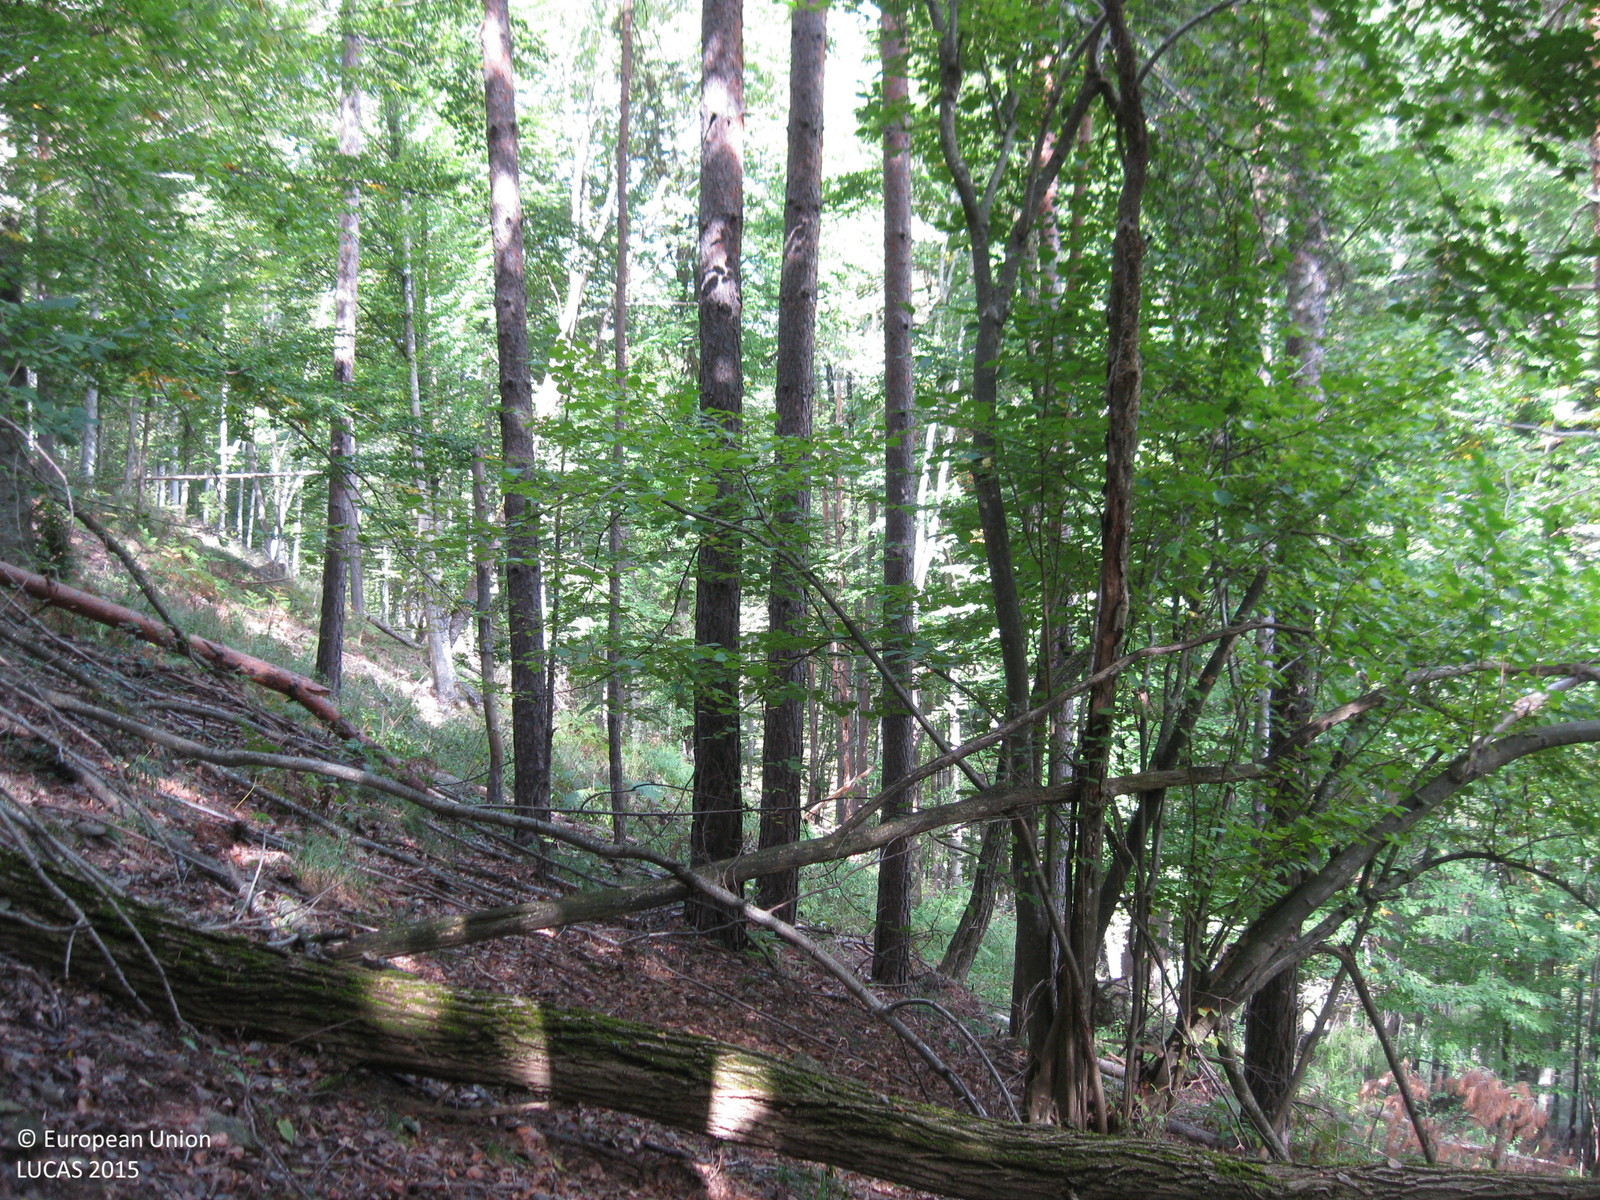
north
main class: Woodland
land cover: Broadleaved woodland
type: mountainous beech forest
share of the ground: > 75 %
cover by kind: broadleaved forest trees 90 %, shrubs 5 %, lichens and mosses 5 %
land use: Forestry
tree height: > 5 m
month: October
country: BG
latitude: 41.7782
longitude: 24.9328
